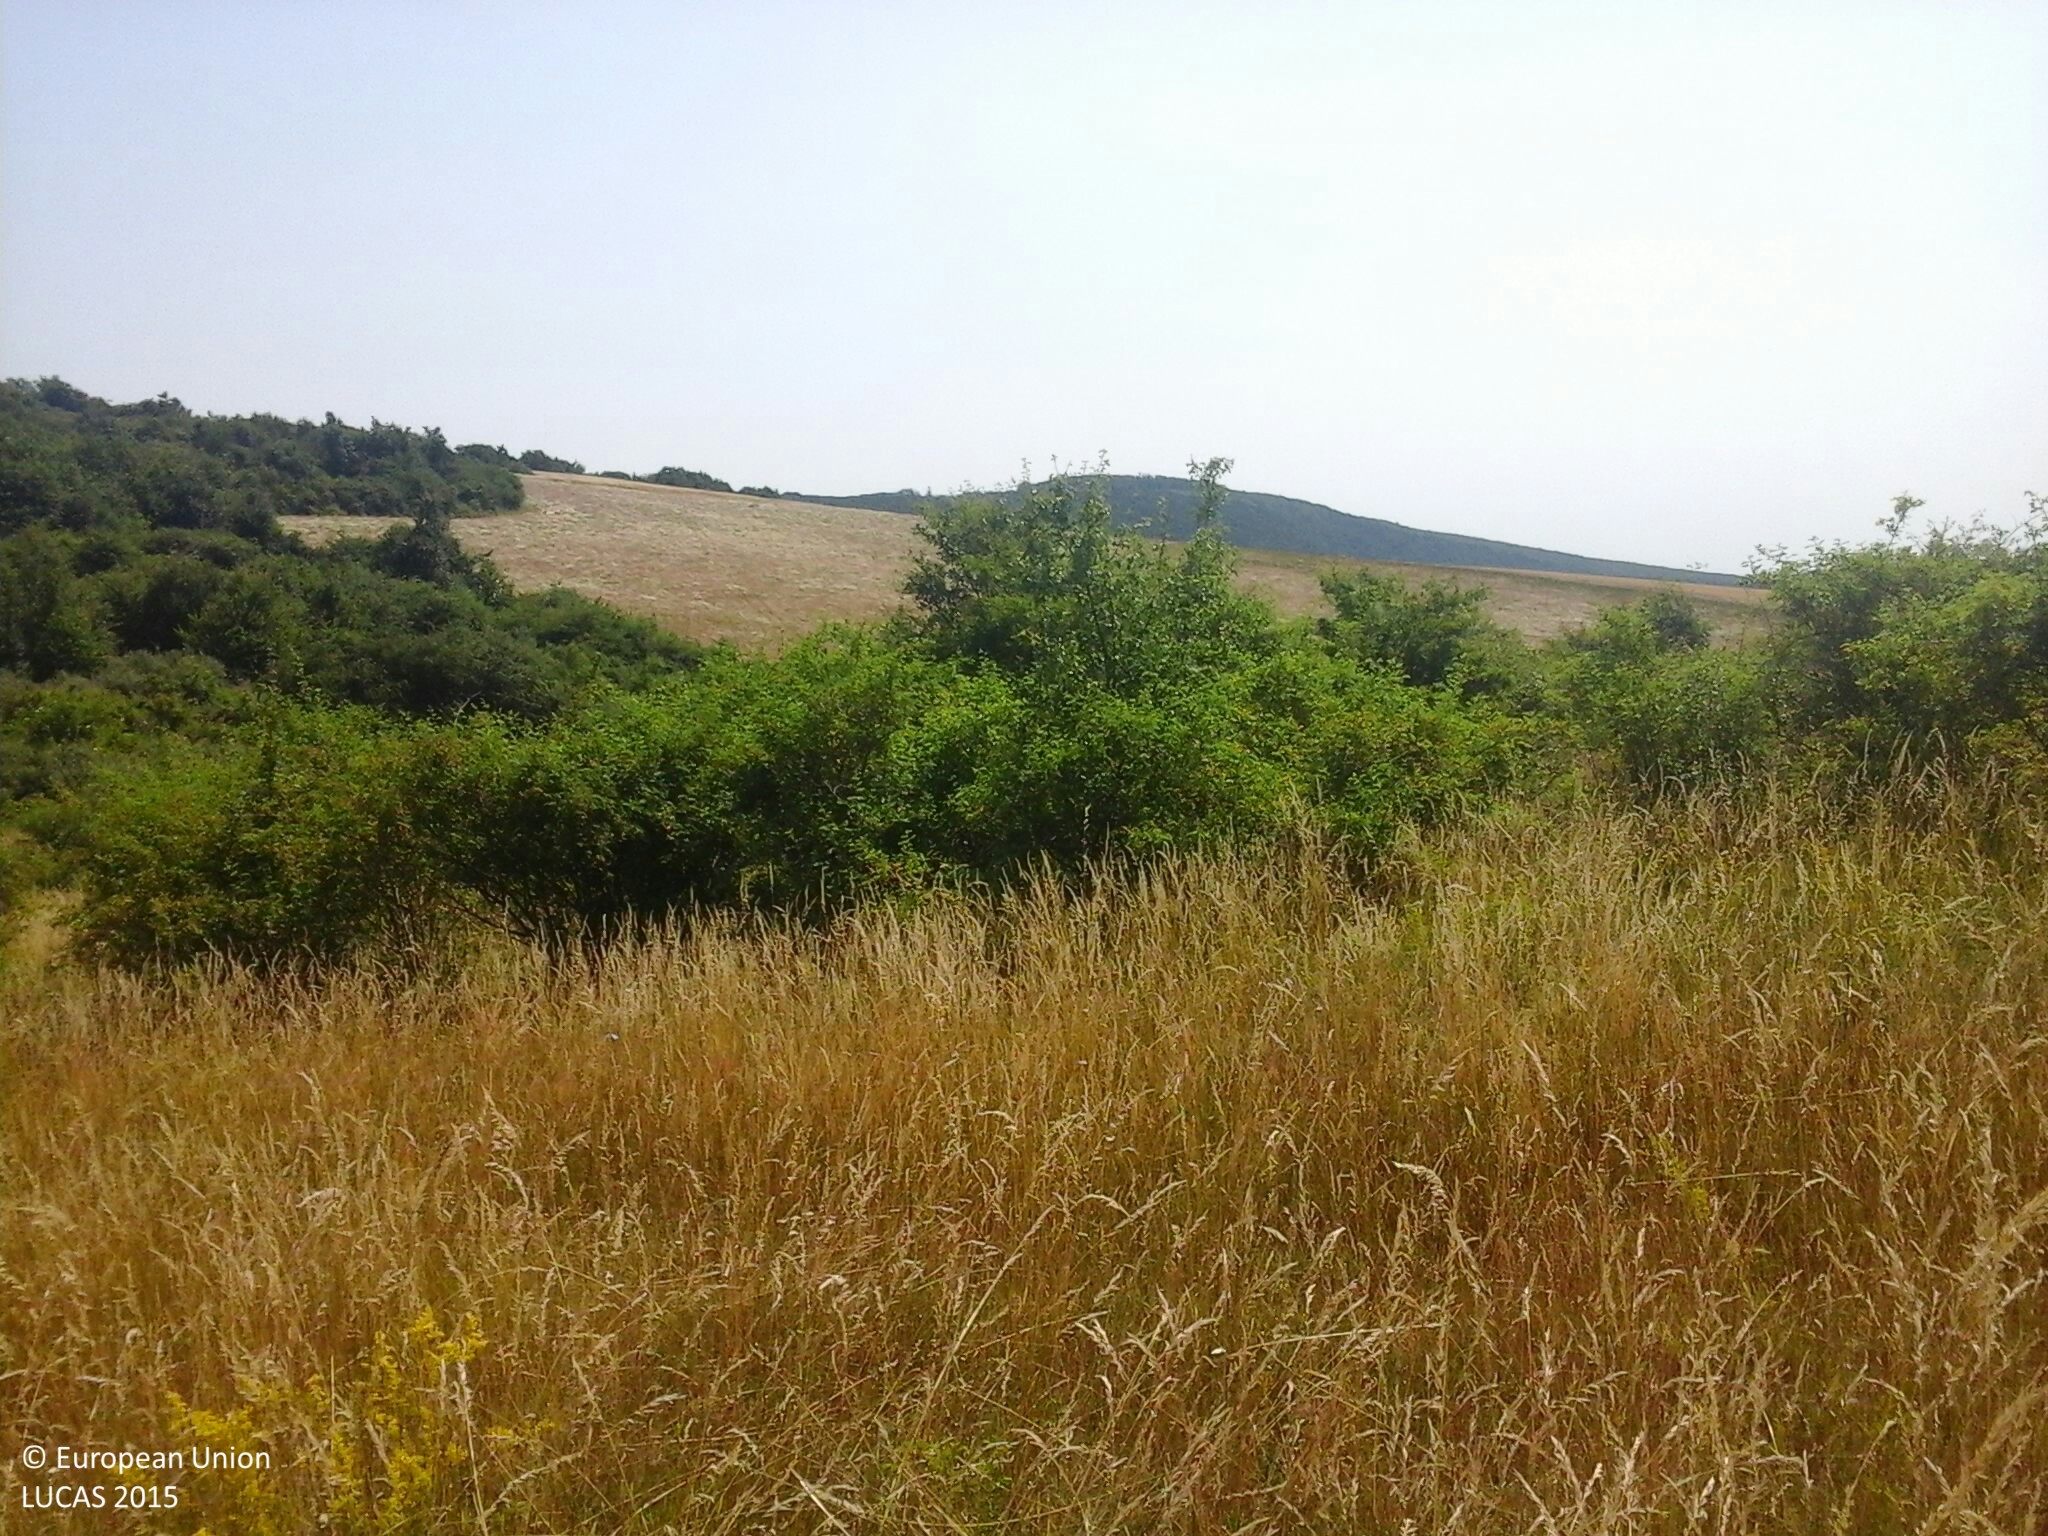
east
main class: Grassland
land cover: Grassland without tree/shrub cover
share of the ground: > 75 %
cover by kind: herbaceous plants 100 %
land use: Agriculture (excluding fallow land and kitchen gardens)
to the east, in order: Grassland without tree/shrub cover; Grassland with sparse tree/shrub cover; Grassland without tree/shrub cover
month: July
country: HU
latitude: 47.2011
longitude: 17.8634
